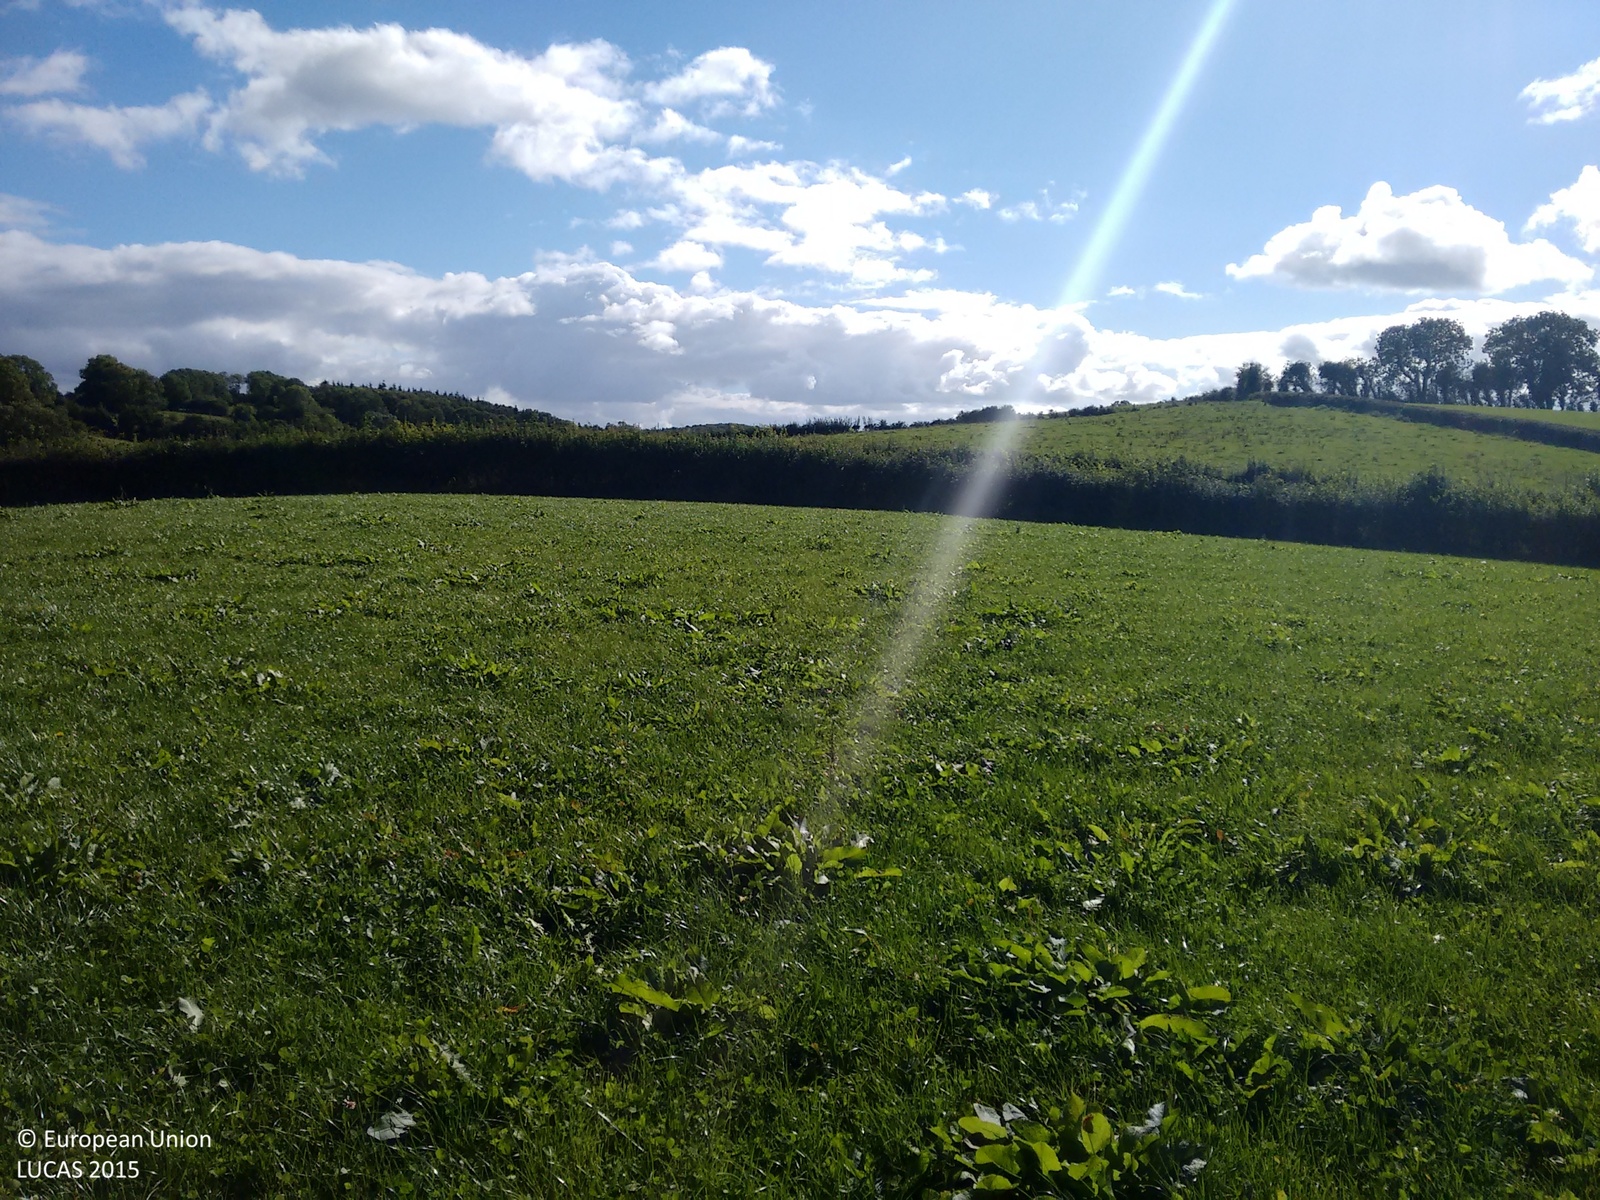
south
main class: Grassland
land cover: Grassland without tree/shrub cover
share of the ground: > 75 %
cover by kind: herbaceous plants 100 %
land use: Agriculture (excluding fallow land and kitchen gardens)
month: September
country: IE
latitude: 54.2467
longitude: -6.8796
